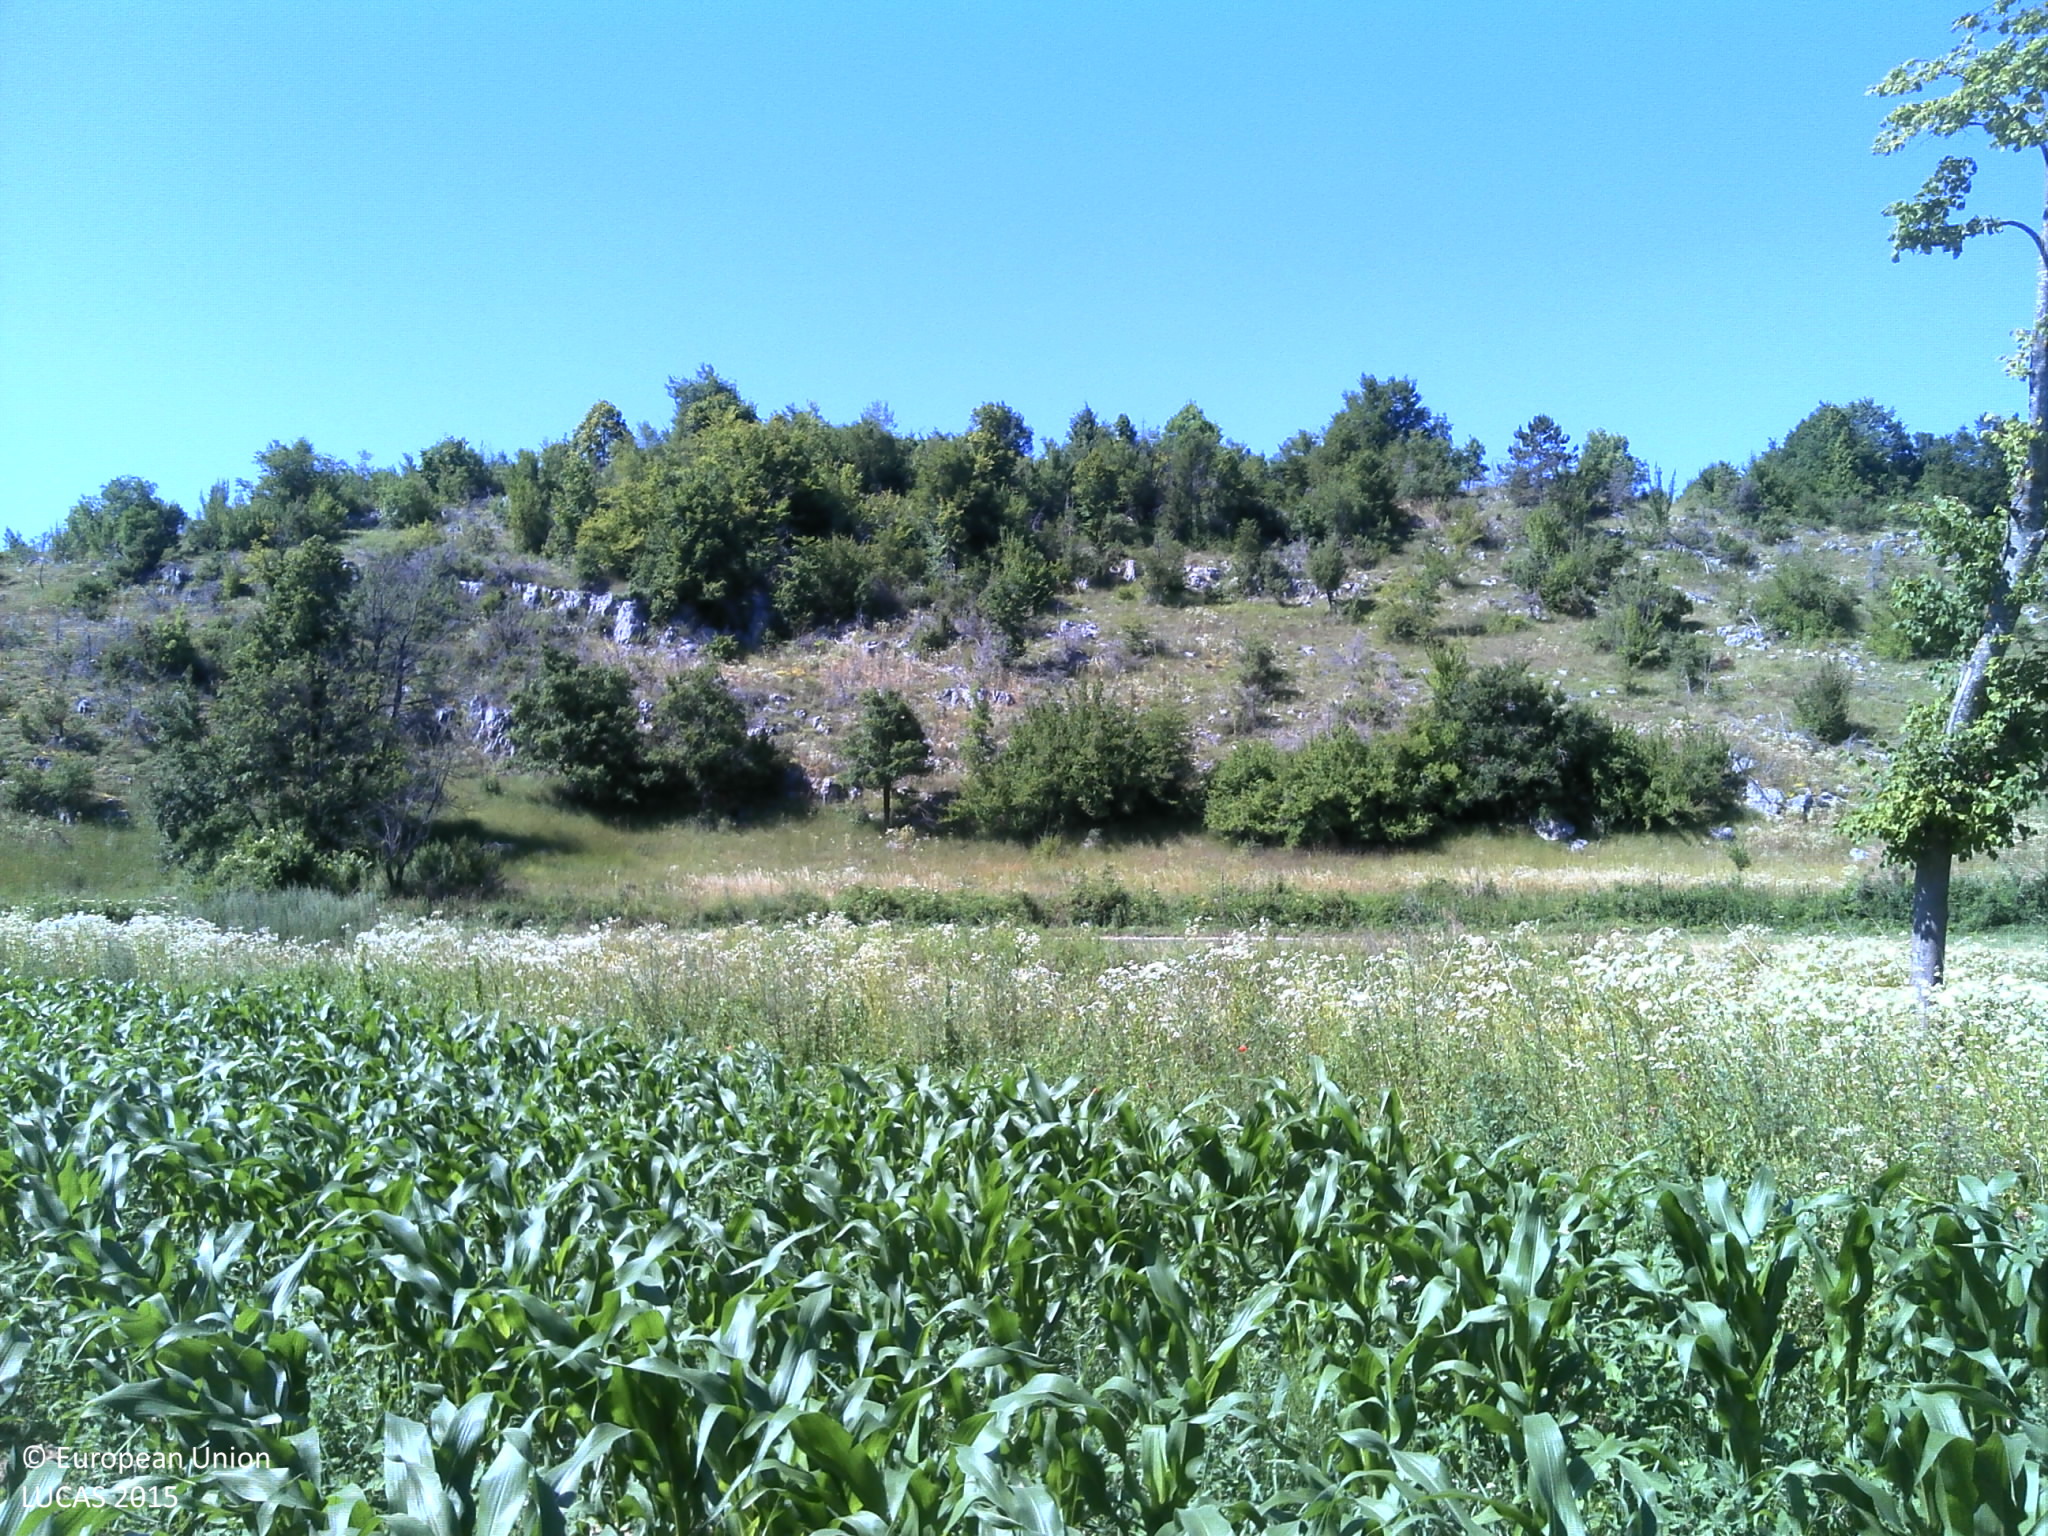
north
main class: Cropland
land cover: Maize
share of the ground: > 75 %
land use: Agriculture (excluding fallow land and kitchen gardens)
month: July
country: HR
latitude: 44.9452
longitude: 15.1526
